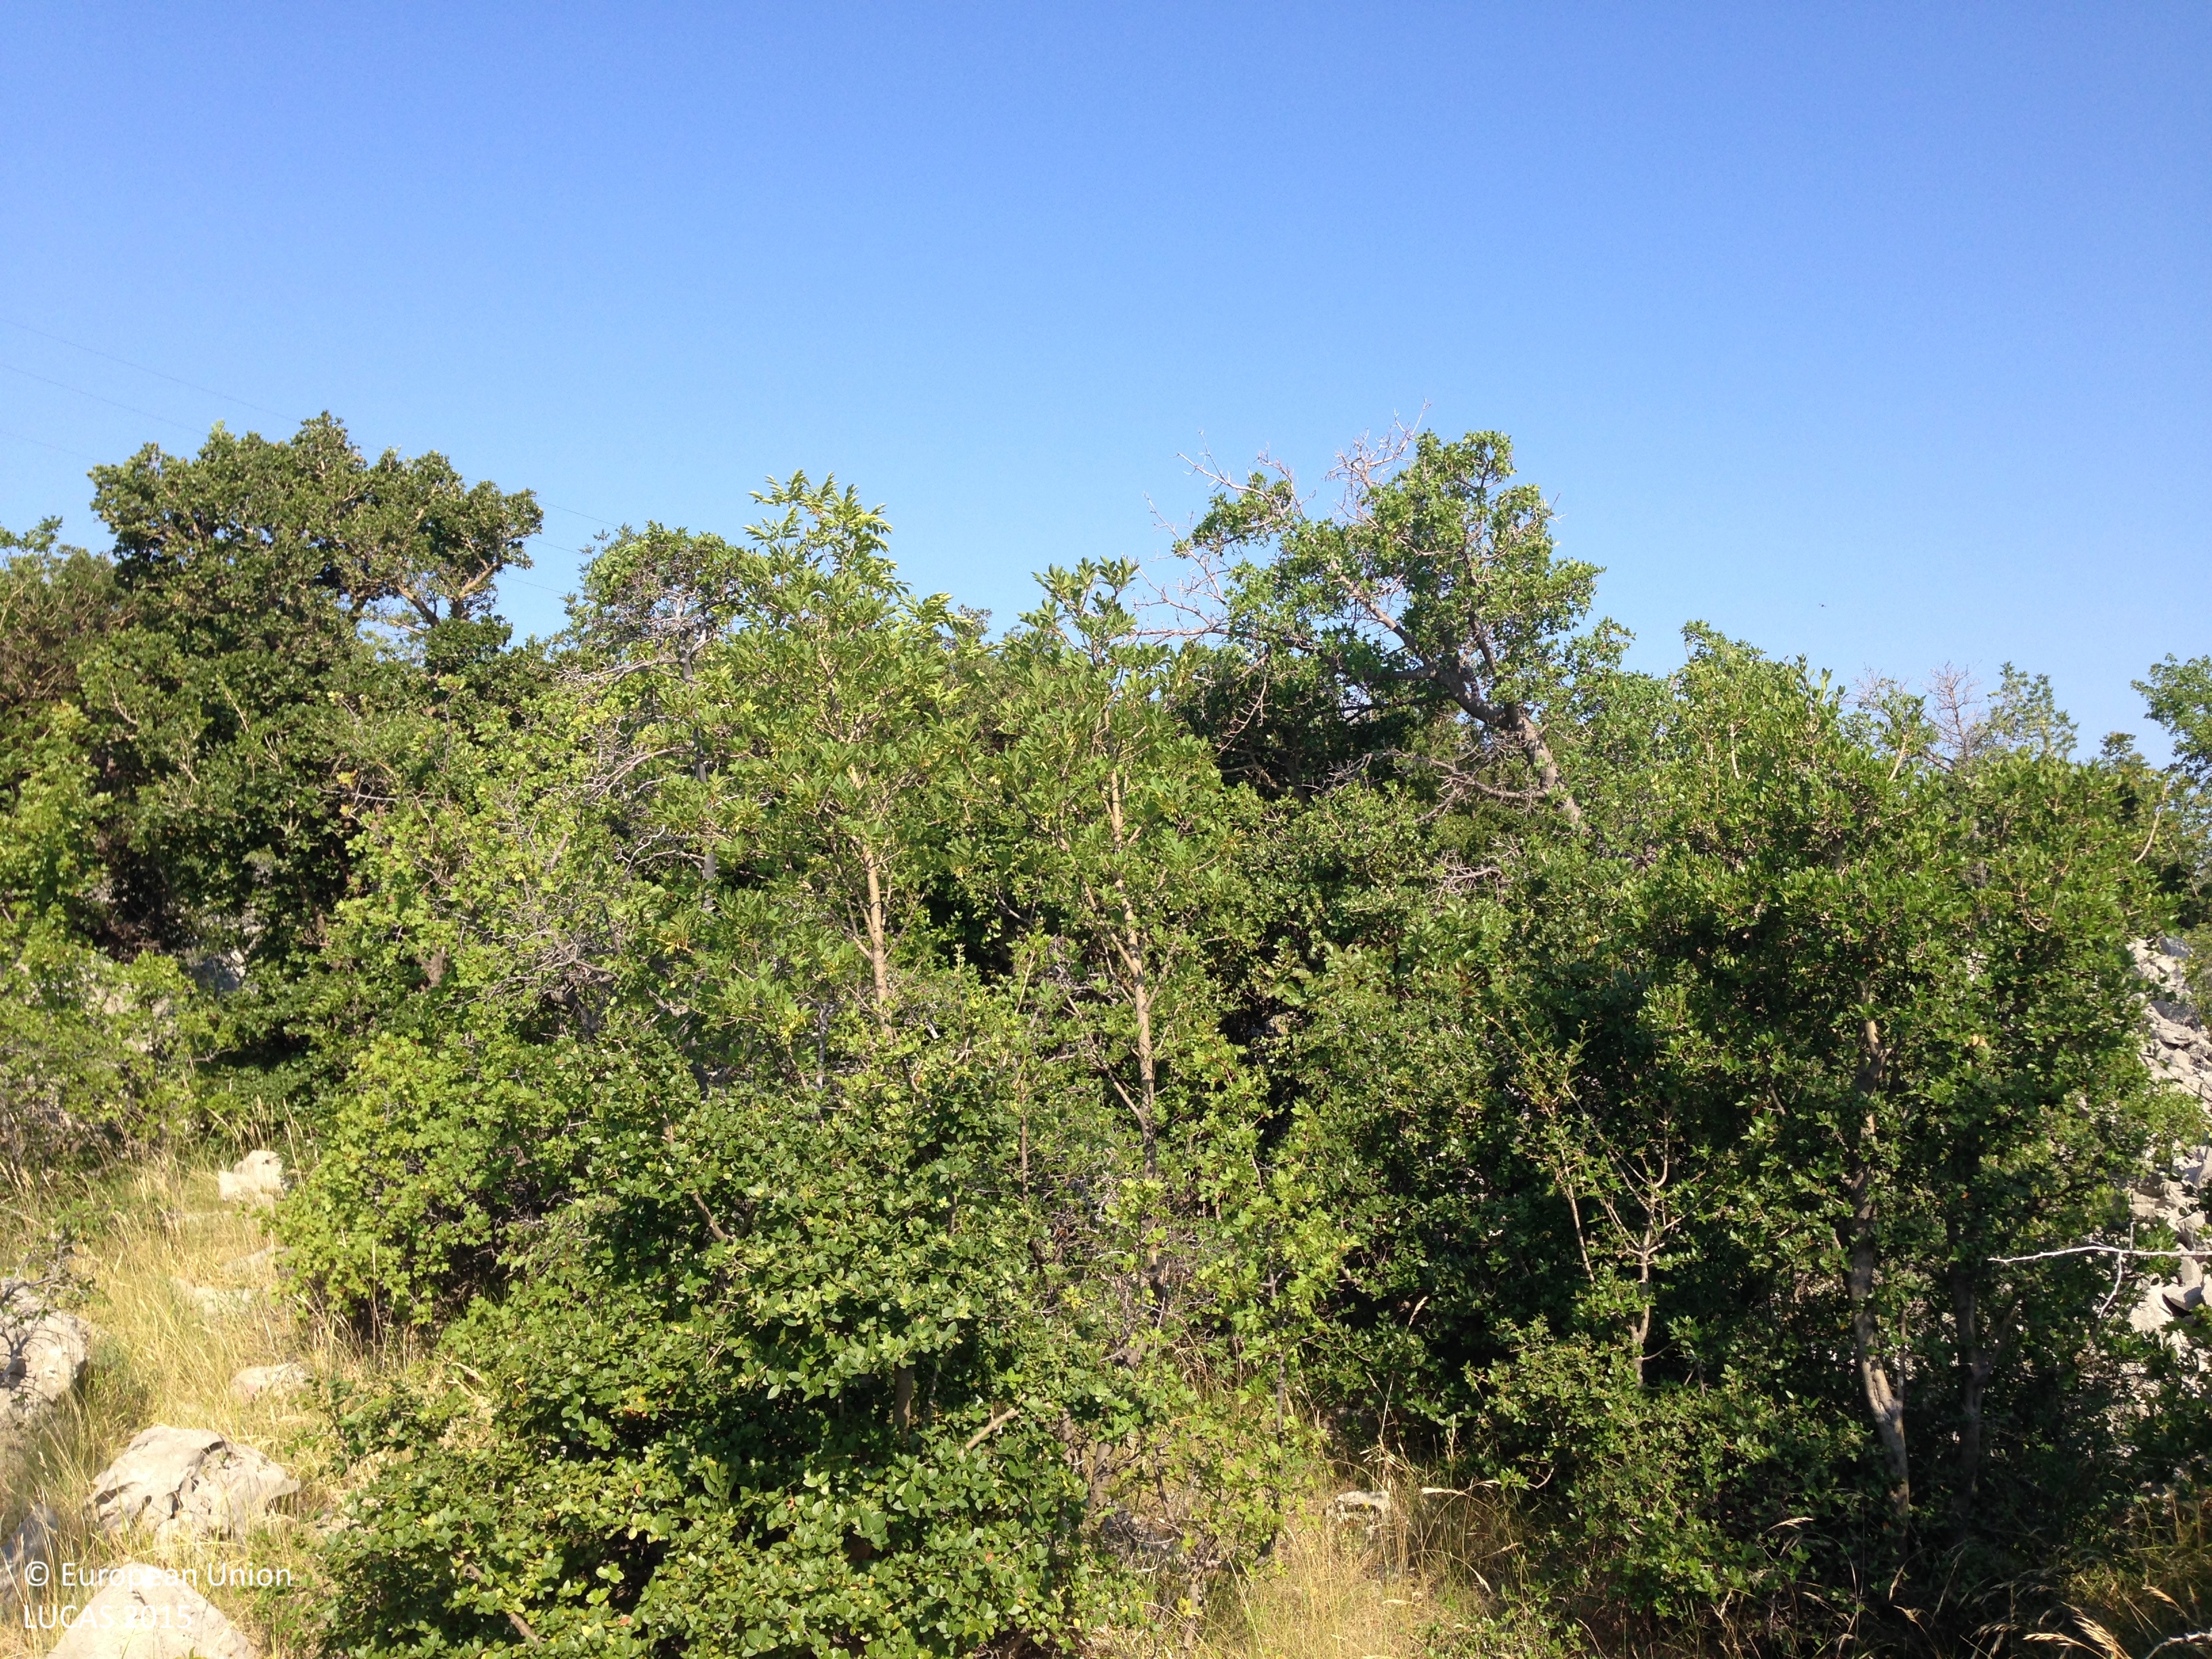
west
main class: Woodland
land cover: Other mixed woodland
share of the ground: 25 - 50 %
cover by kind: unconsolidated bare surface 30 %, herbaceous plants 20 %, broadleaved forest trees 15 %, shrubs 15 %, coniferous forest trees 10 %, consolidated bare surface 10 %
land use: Semi-natural and natural areas not in use
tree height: < 5 m
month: July
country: HR
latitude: 44.5917
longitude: 14.9942
